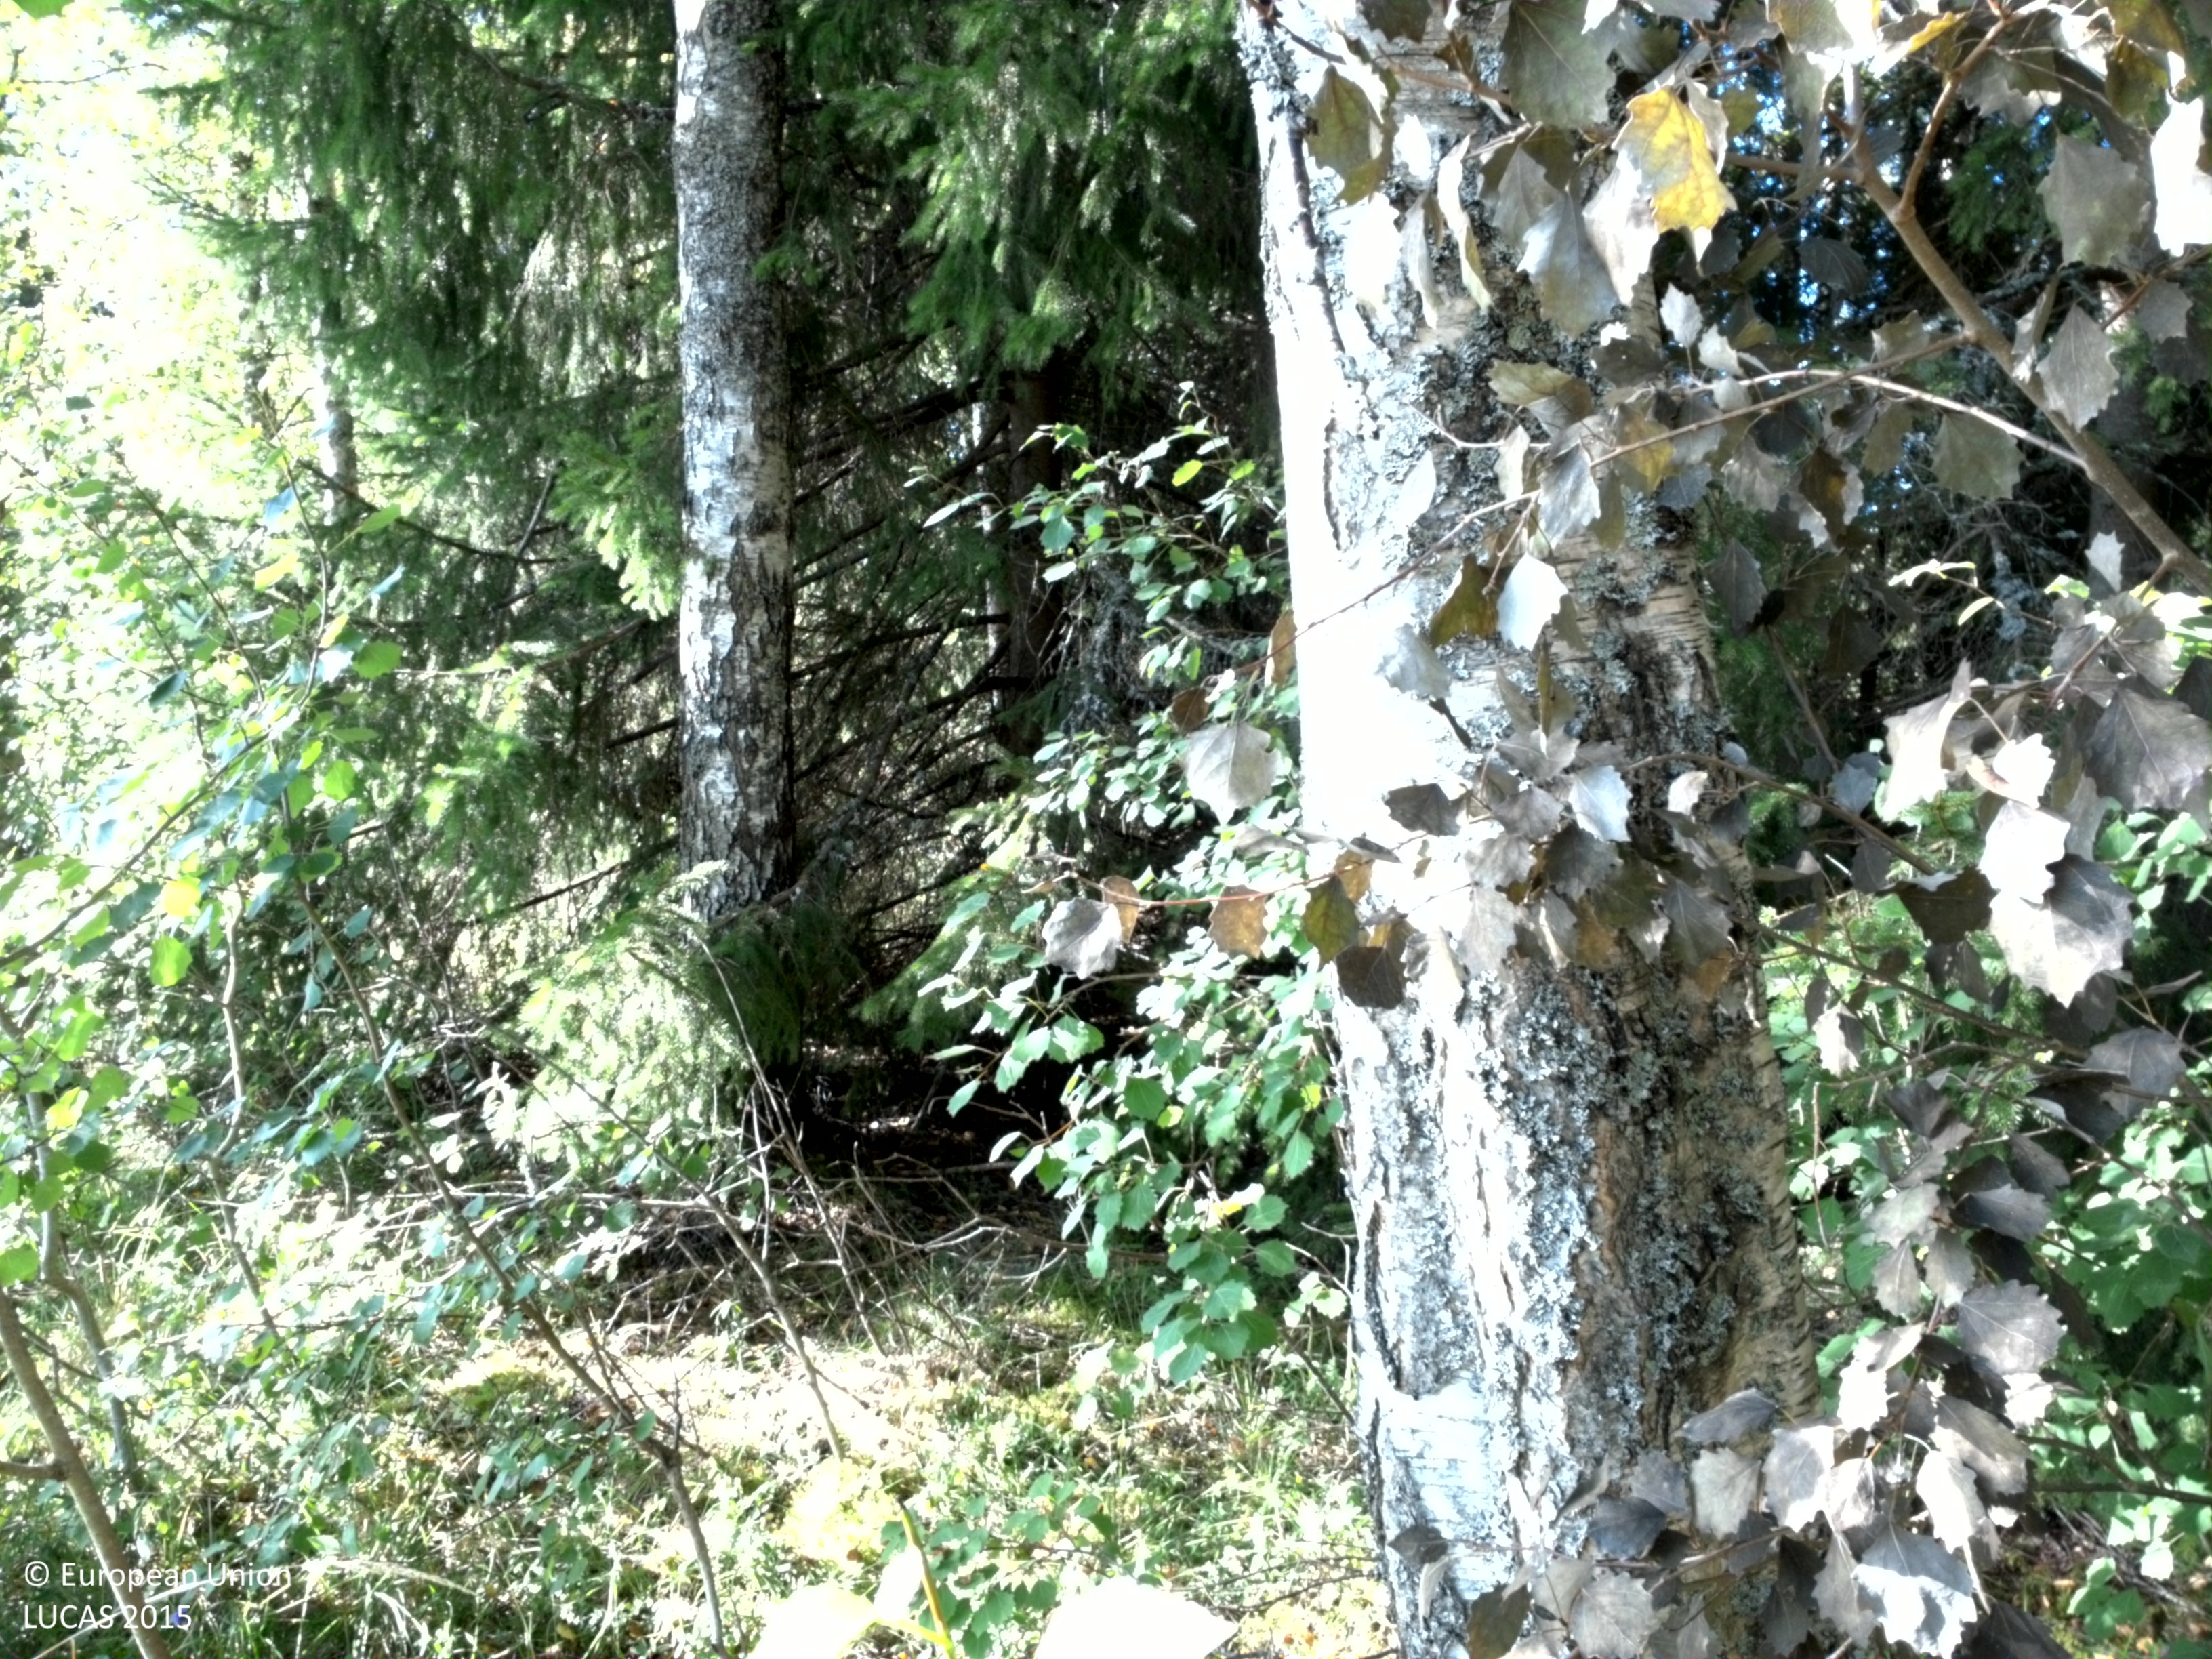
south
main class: Woodland
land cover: Spruce dominated mixed woodland
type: boreal forest
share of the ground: > 75 %
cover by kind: coniferous forest trees 60 %, broadleaved forest trees 20 %, herbaceous plants 20 %
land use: Forestry
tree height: > 5 m
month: August
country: SE
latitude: 59.9172
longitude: 16.9852
